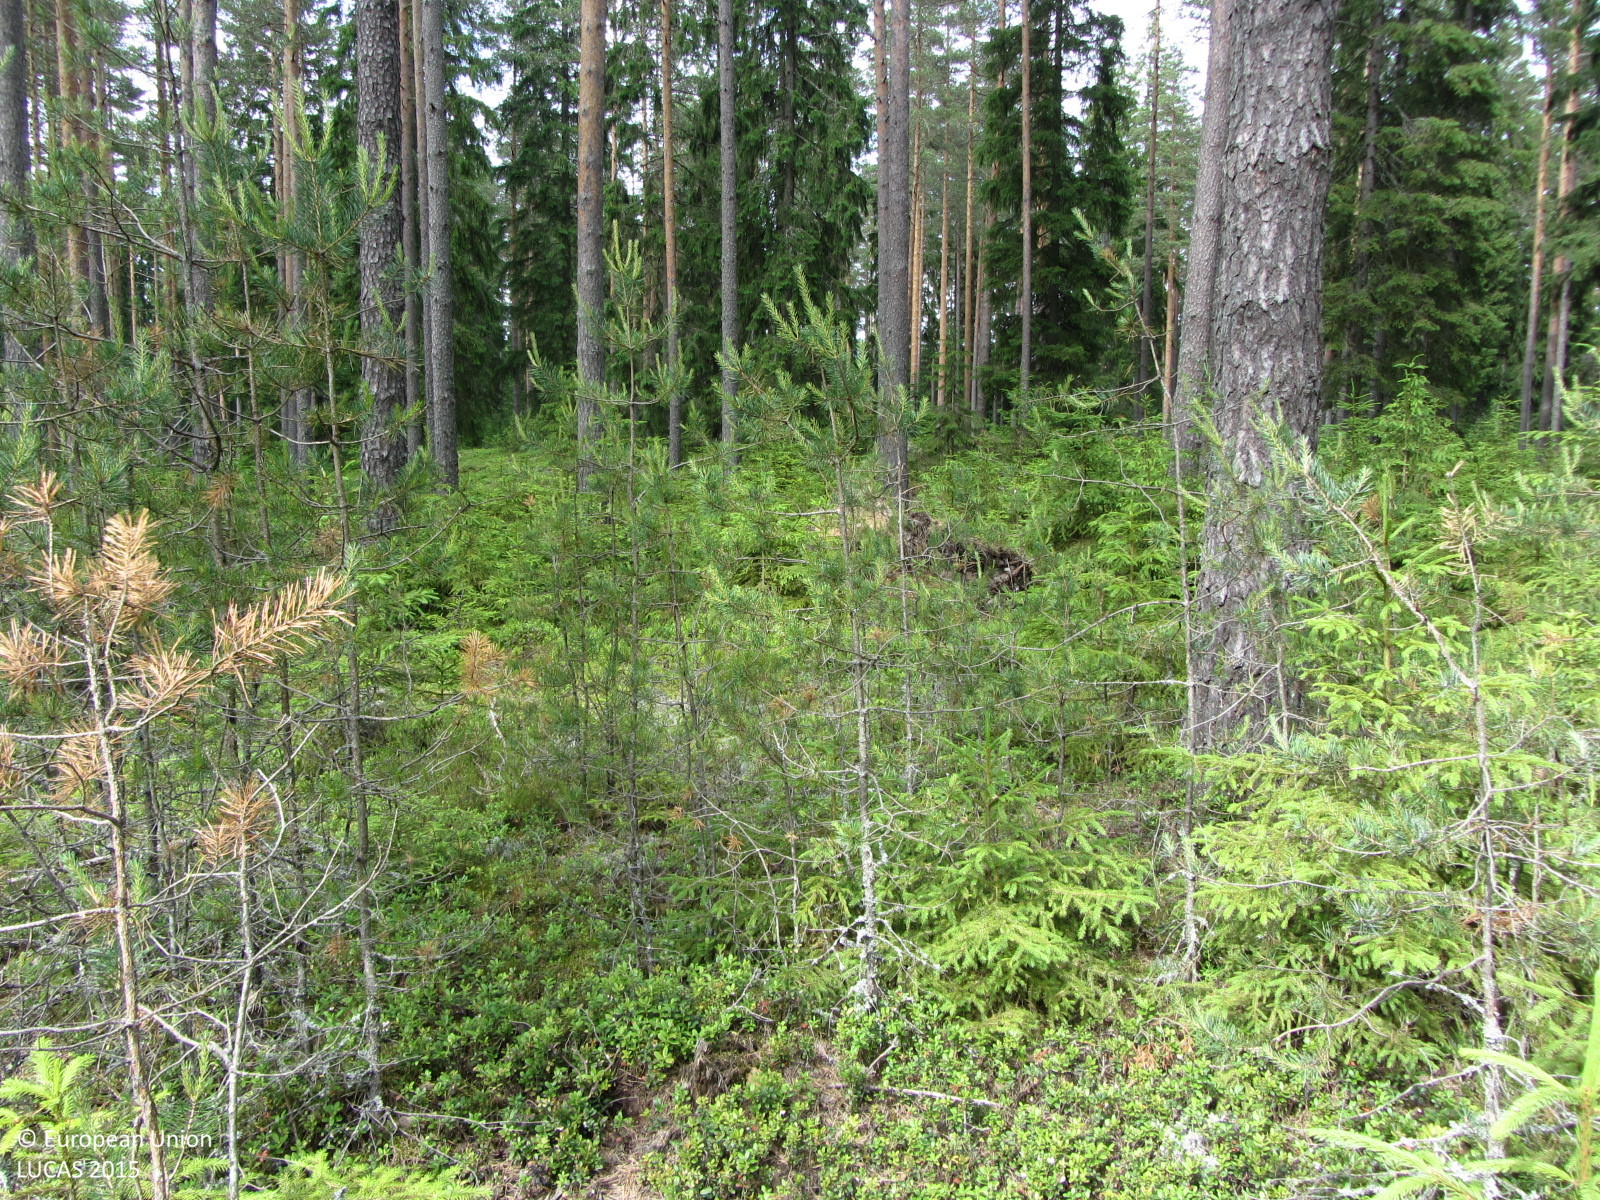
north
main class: Woodland
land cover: Other coniferous woodland
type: boreal forest
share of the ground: > 75 %
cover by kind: coniferous forest trees 75 %, shrubs 15 %, lichens and mosses 10 %
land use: Forestry
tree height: > 5 m
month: June
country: FI
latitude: 60.1057
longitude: 23.1969
